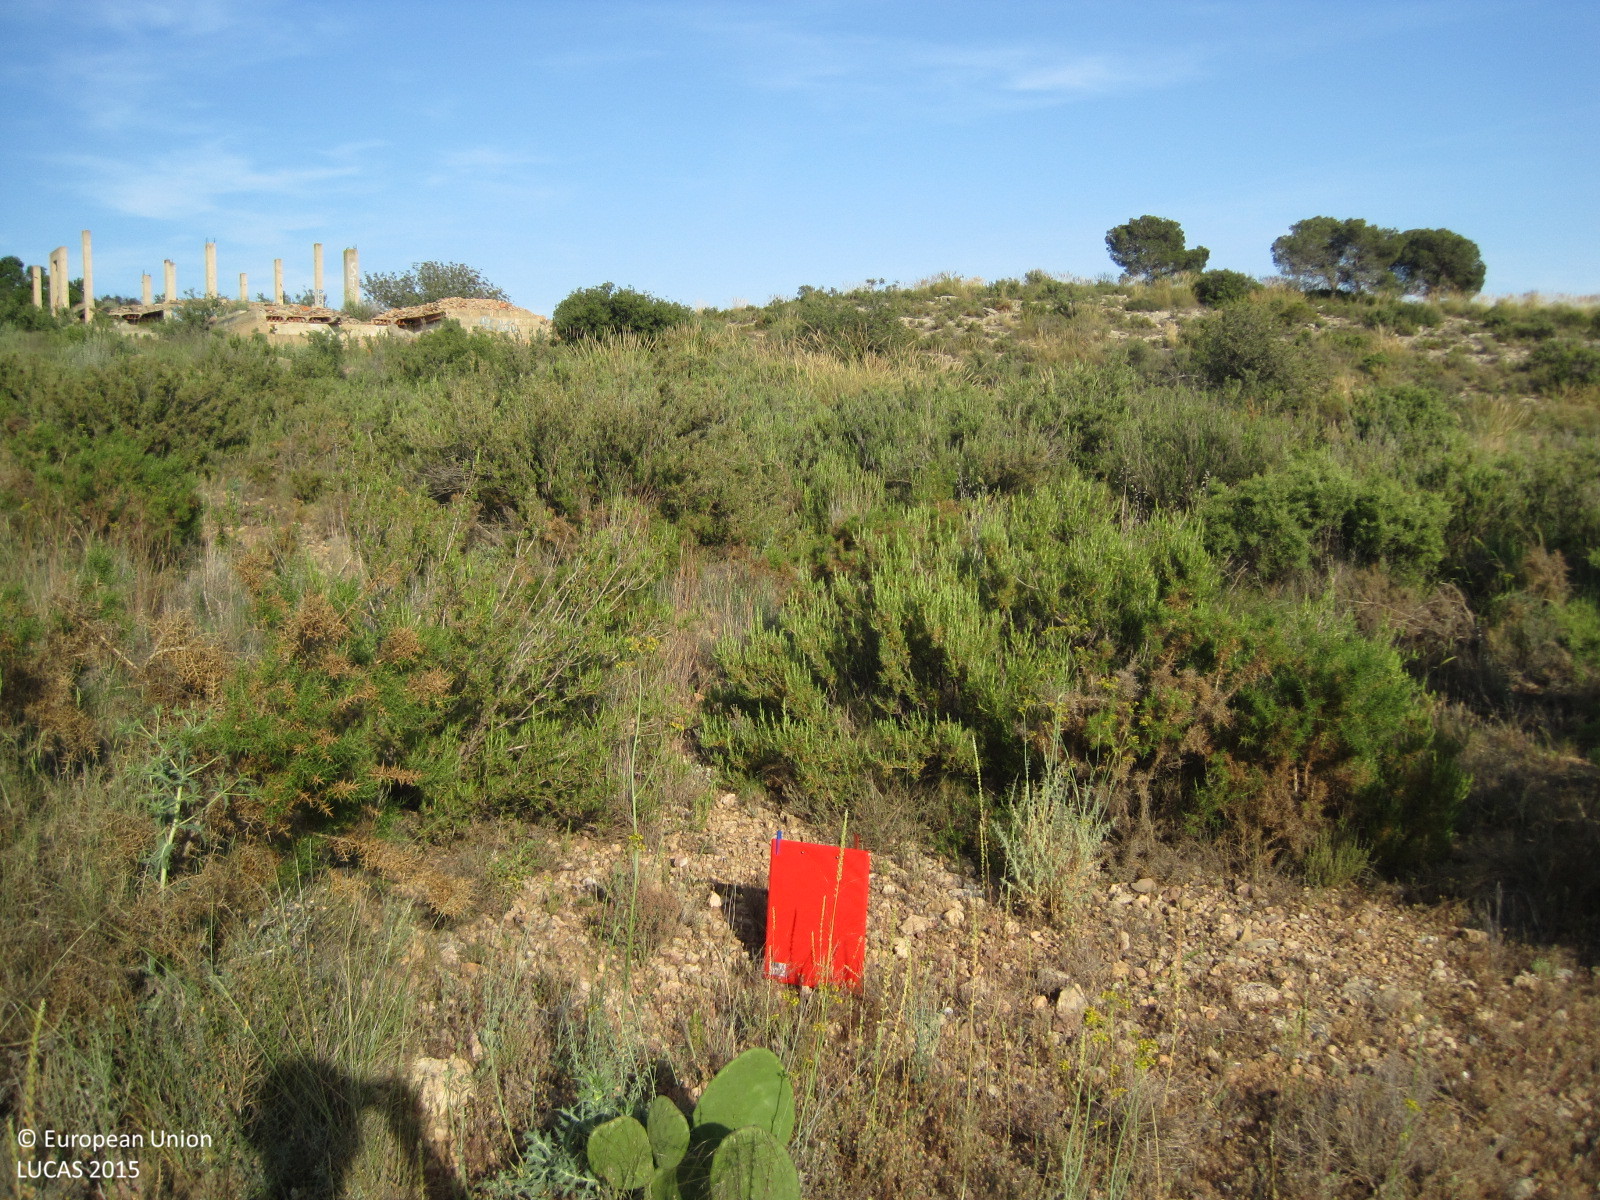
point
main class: Shrubland
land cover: Shrubland without tree cover
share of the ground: > 75 %
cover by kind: shrubs 80 %, consolidated bare surface 15 %, herbaceous plants 5 %
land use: Semi-natural and natural areas not in use
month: May
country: ES
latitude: 39.6838
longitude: -0.6696
